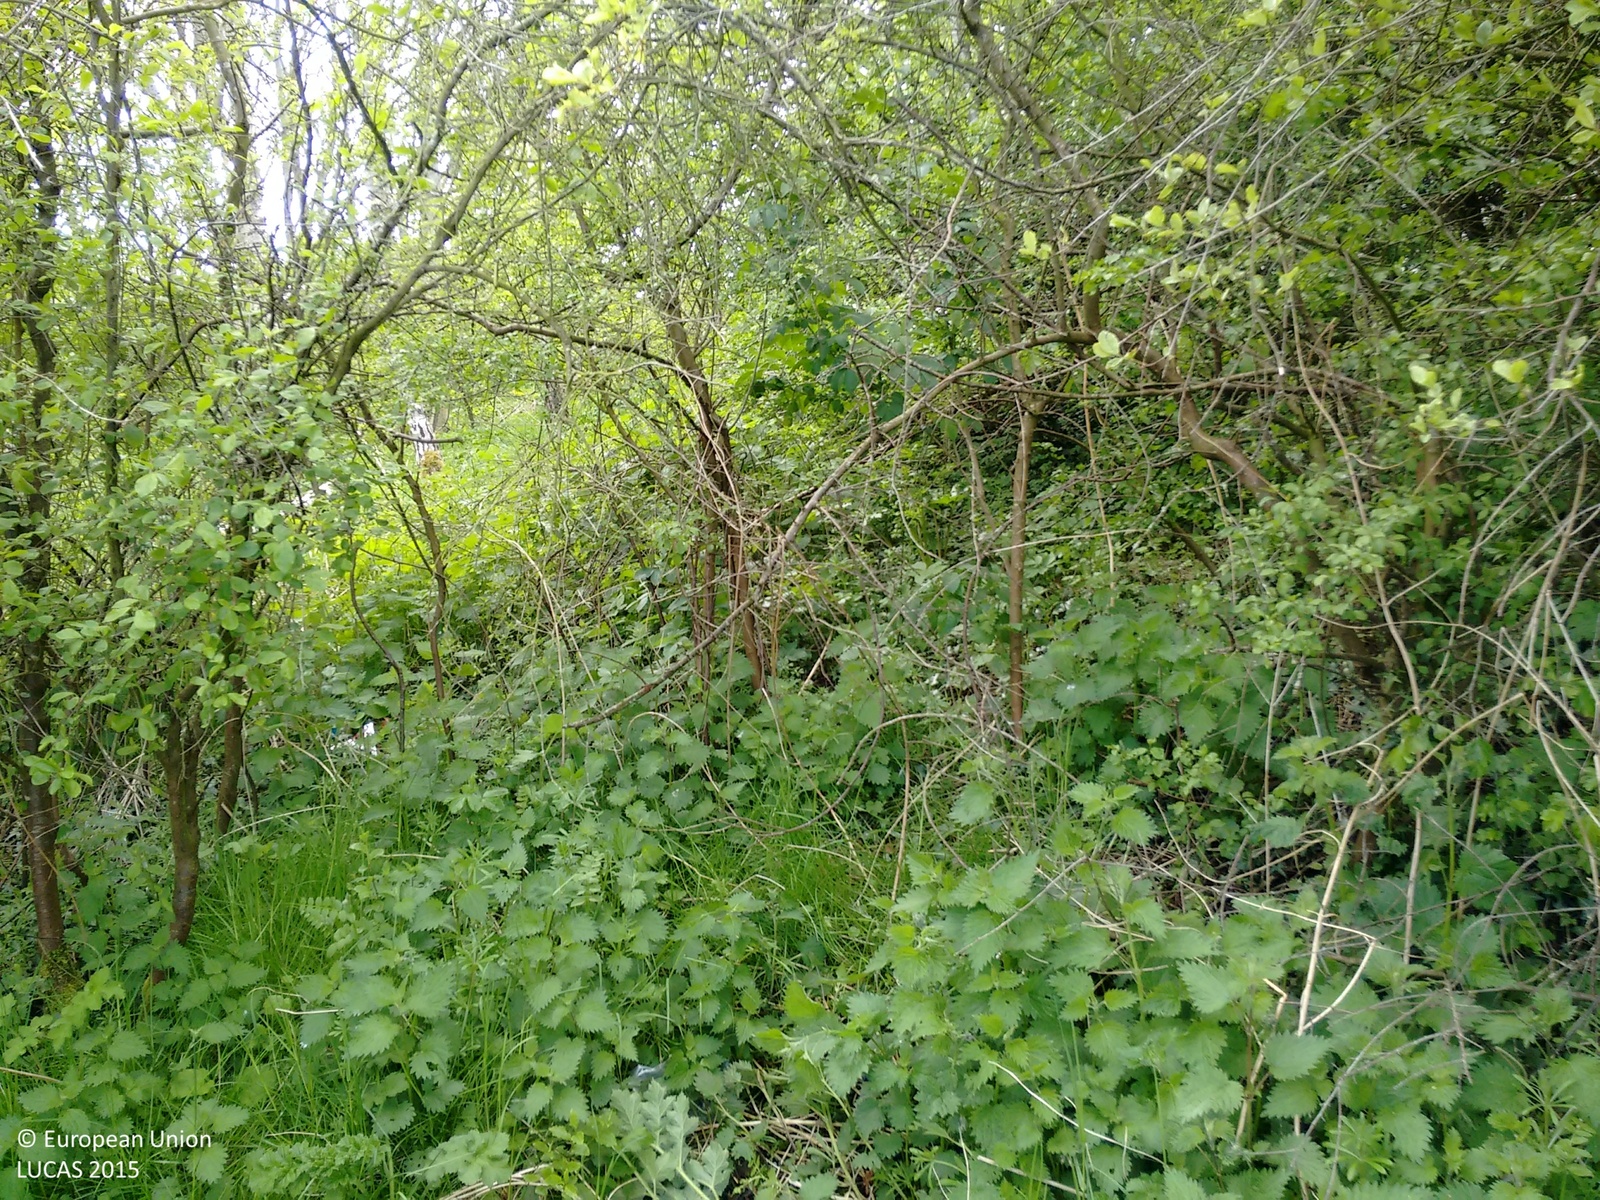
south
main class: Woodland
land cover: Broadleaved woodland
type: mesophytic deciduous forest
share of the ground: > 75 %
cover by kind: broadleaved forest trees 75 %, herbaceous plants 25 %
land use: Amenities, museums, leisure
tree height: > 5 m
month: May
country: GB
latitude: 56.6714
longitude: -3.0062
